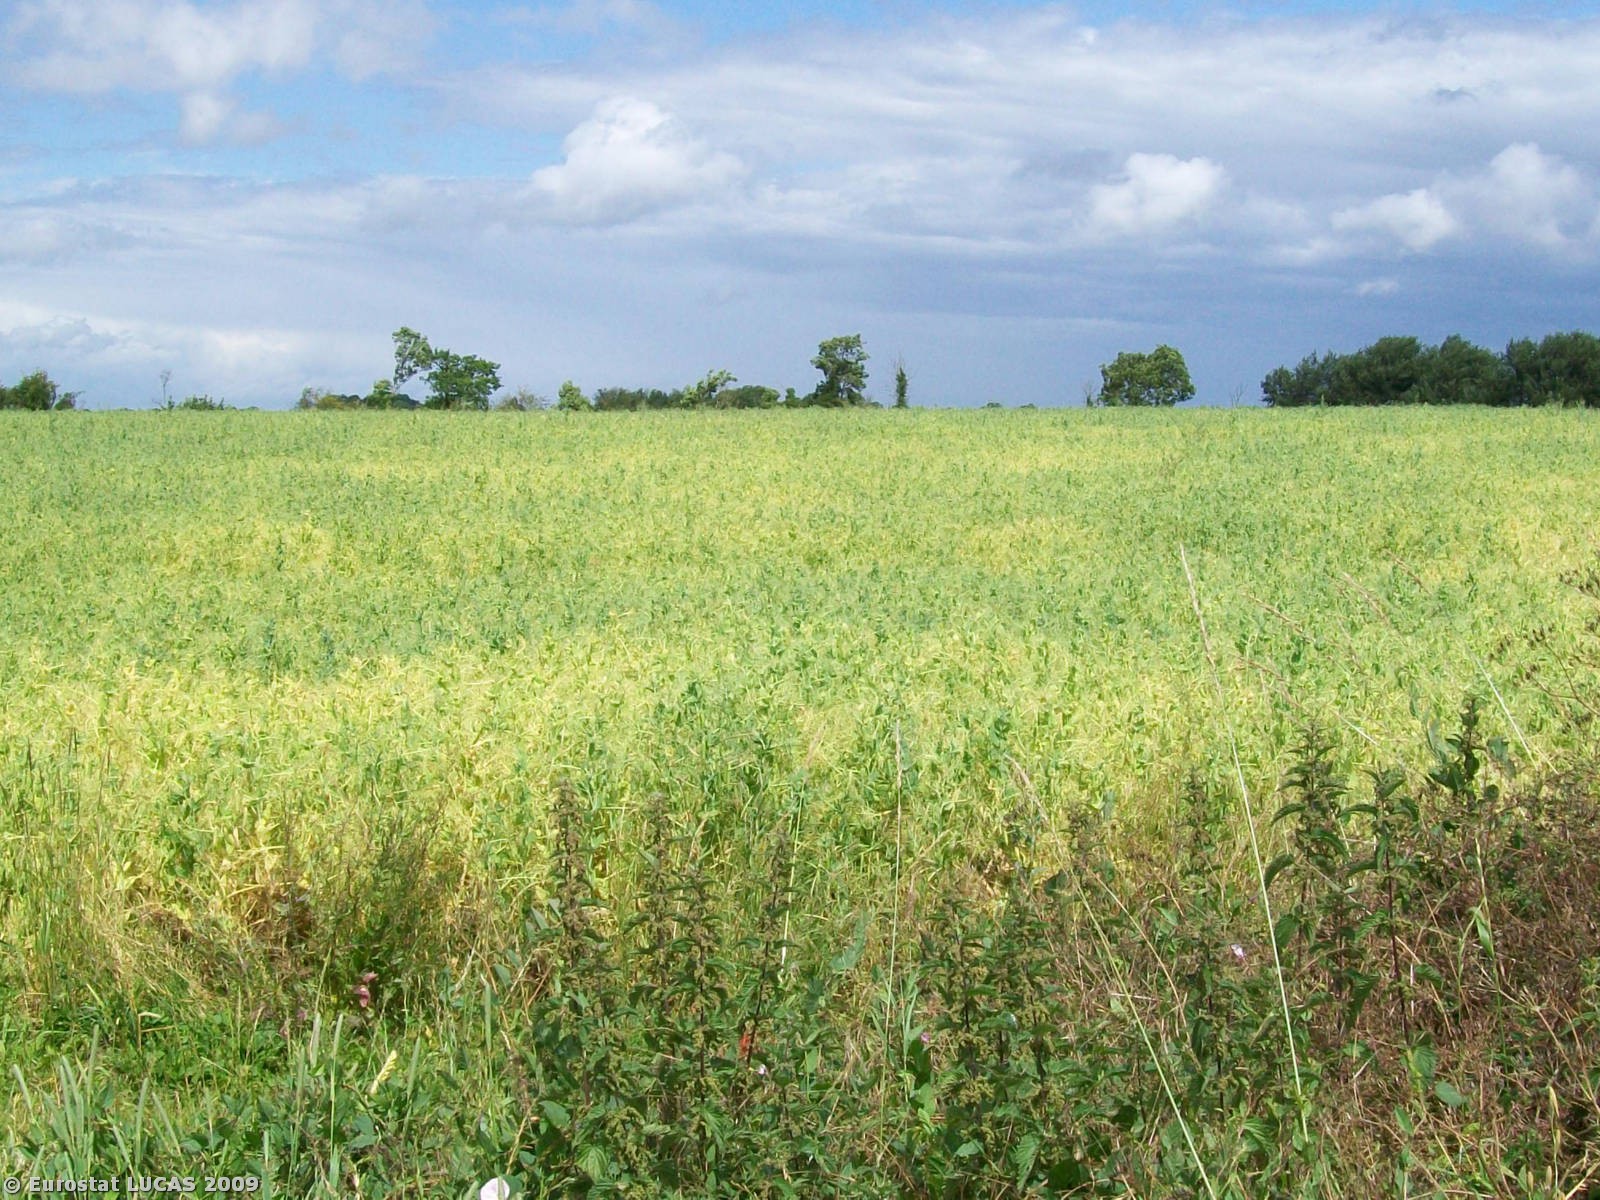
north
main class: Cropland
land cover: Rape and turnip rape
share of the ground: > 75 %
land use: Agriculture (excluding fallow land and kitchen gardens)
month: July
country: GB
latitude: 52.0275
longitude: -1.1967
